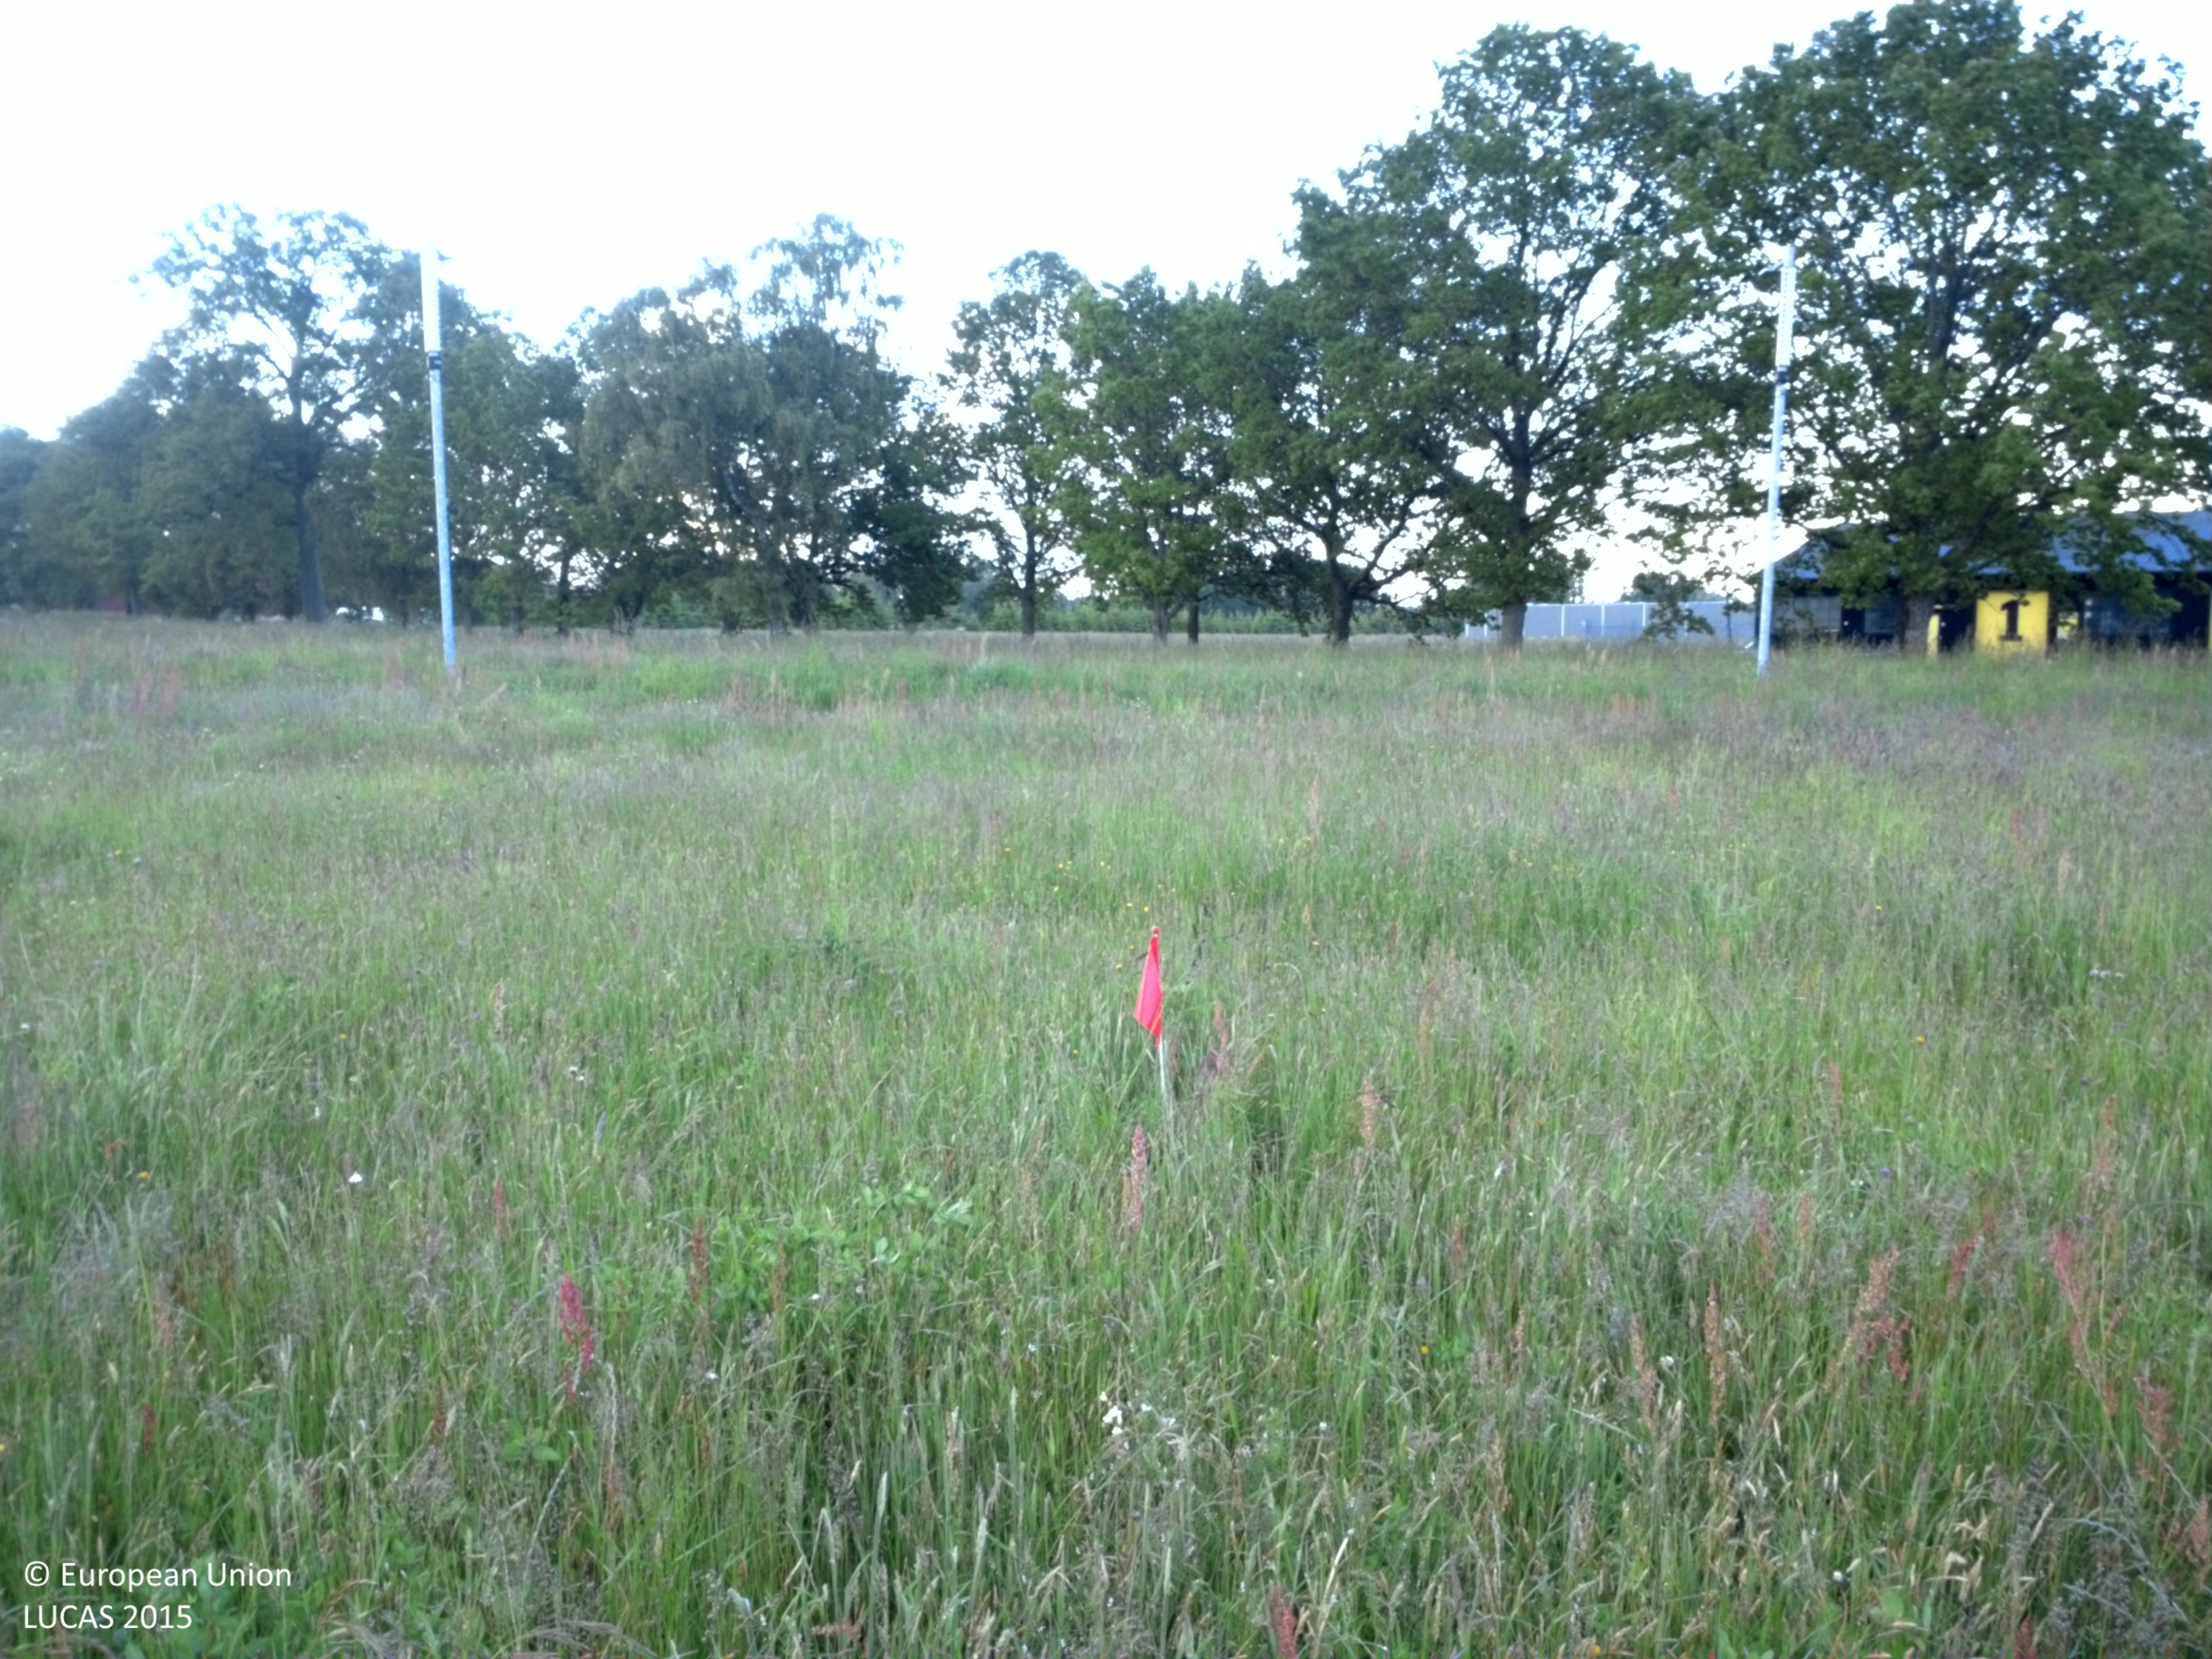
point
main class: Grassland
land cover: Grassland without tree/shrub cover
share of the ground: > 75 %
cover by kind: herbaceous plants 100 %
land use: Agriculture (excluding fallow land and kitchen gardens)
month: June
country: SE
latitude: 58.3136
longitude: 14.2782
